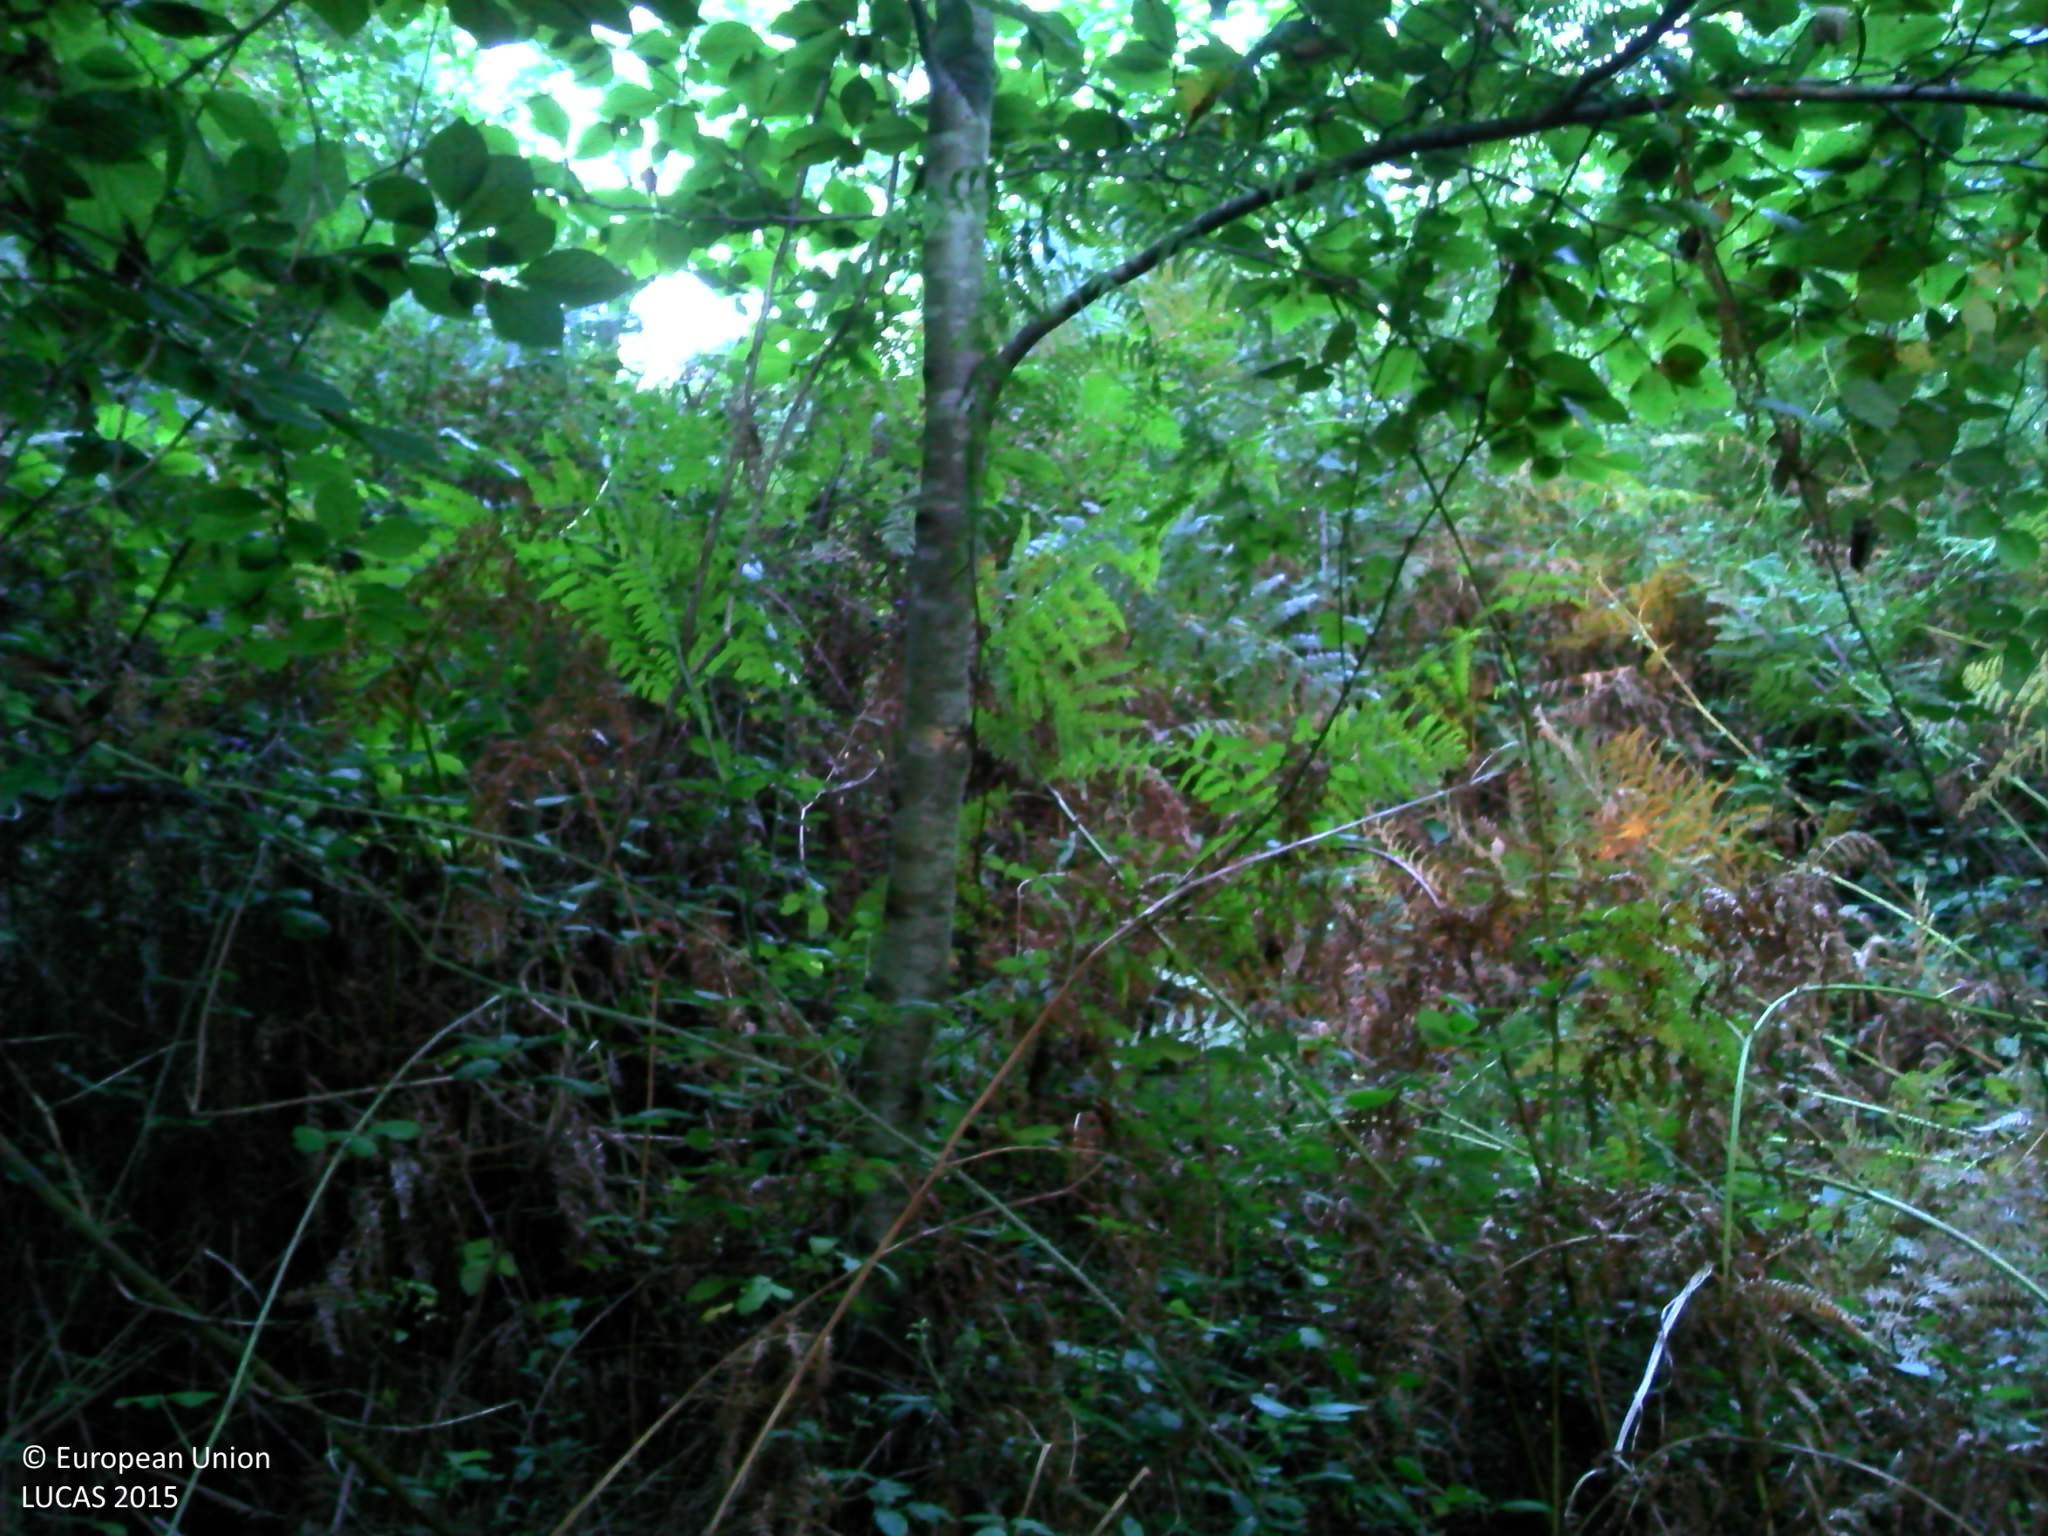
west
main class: Woodland
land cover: Broadleaved woodland
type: beech forest
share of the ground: > 75 %
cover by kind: broadleaved forest trees 80 %, shrubs 10 %, herbaceous plants 10 %
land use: Forestry
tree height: > 5 m
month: September
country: FR
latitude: 43.1775
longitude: -0.6992
